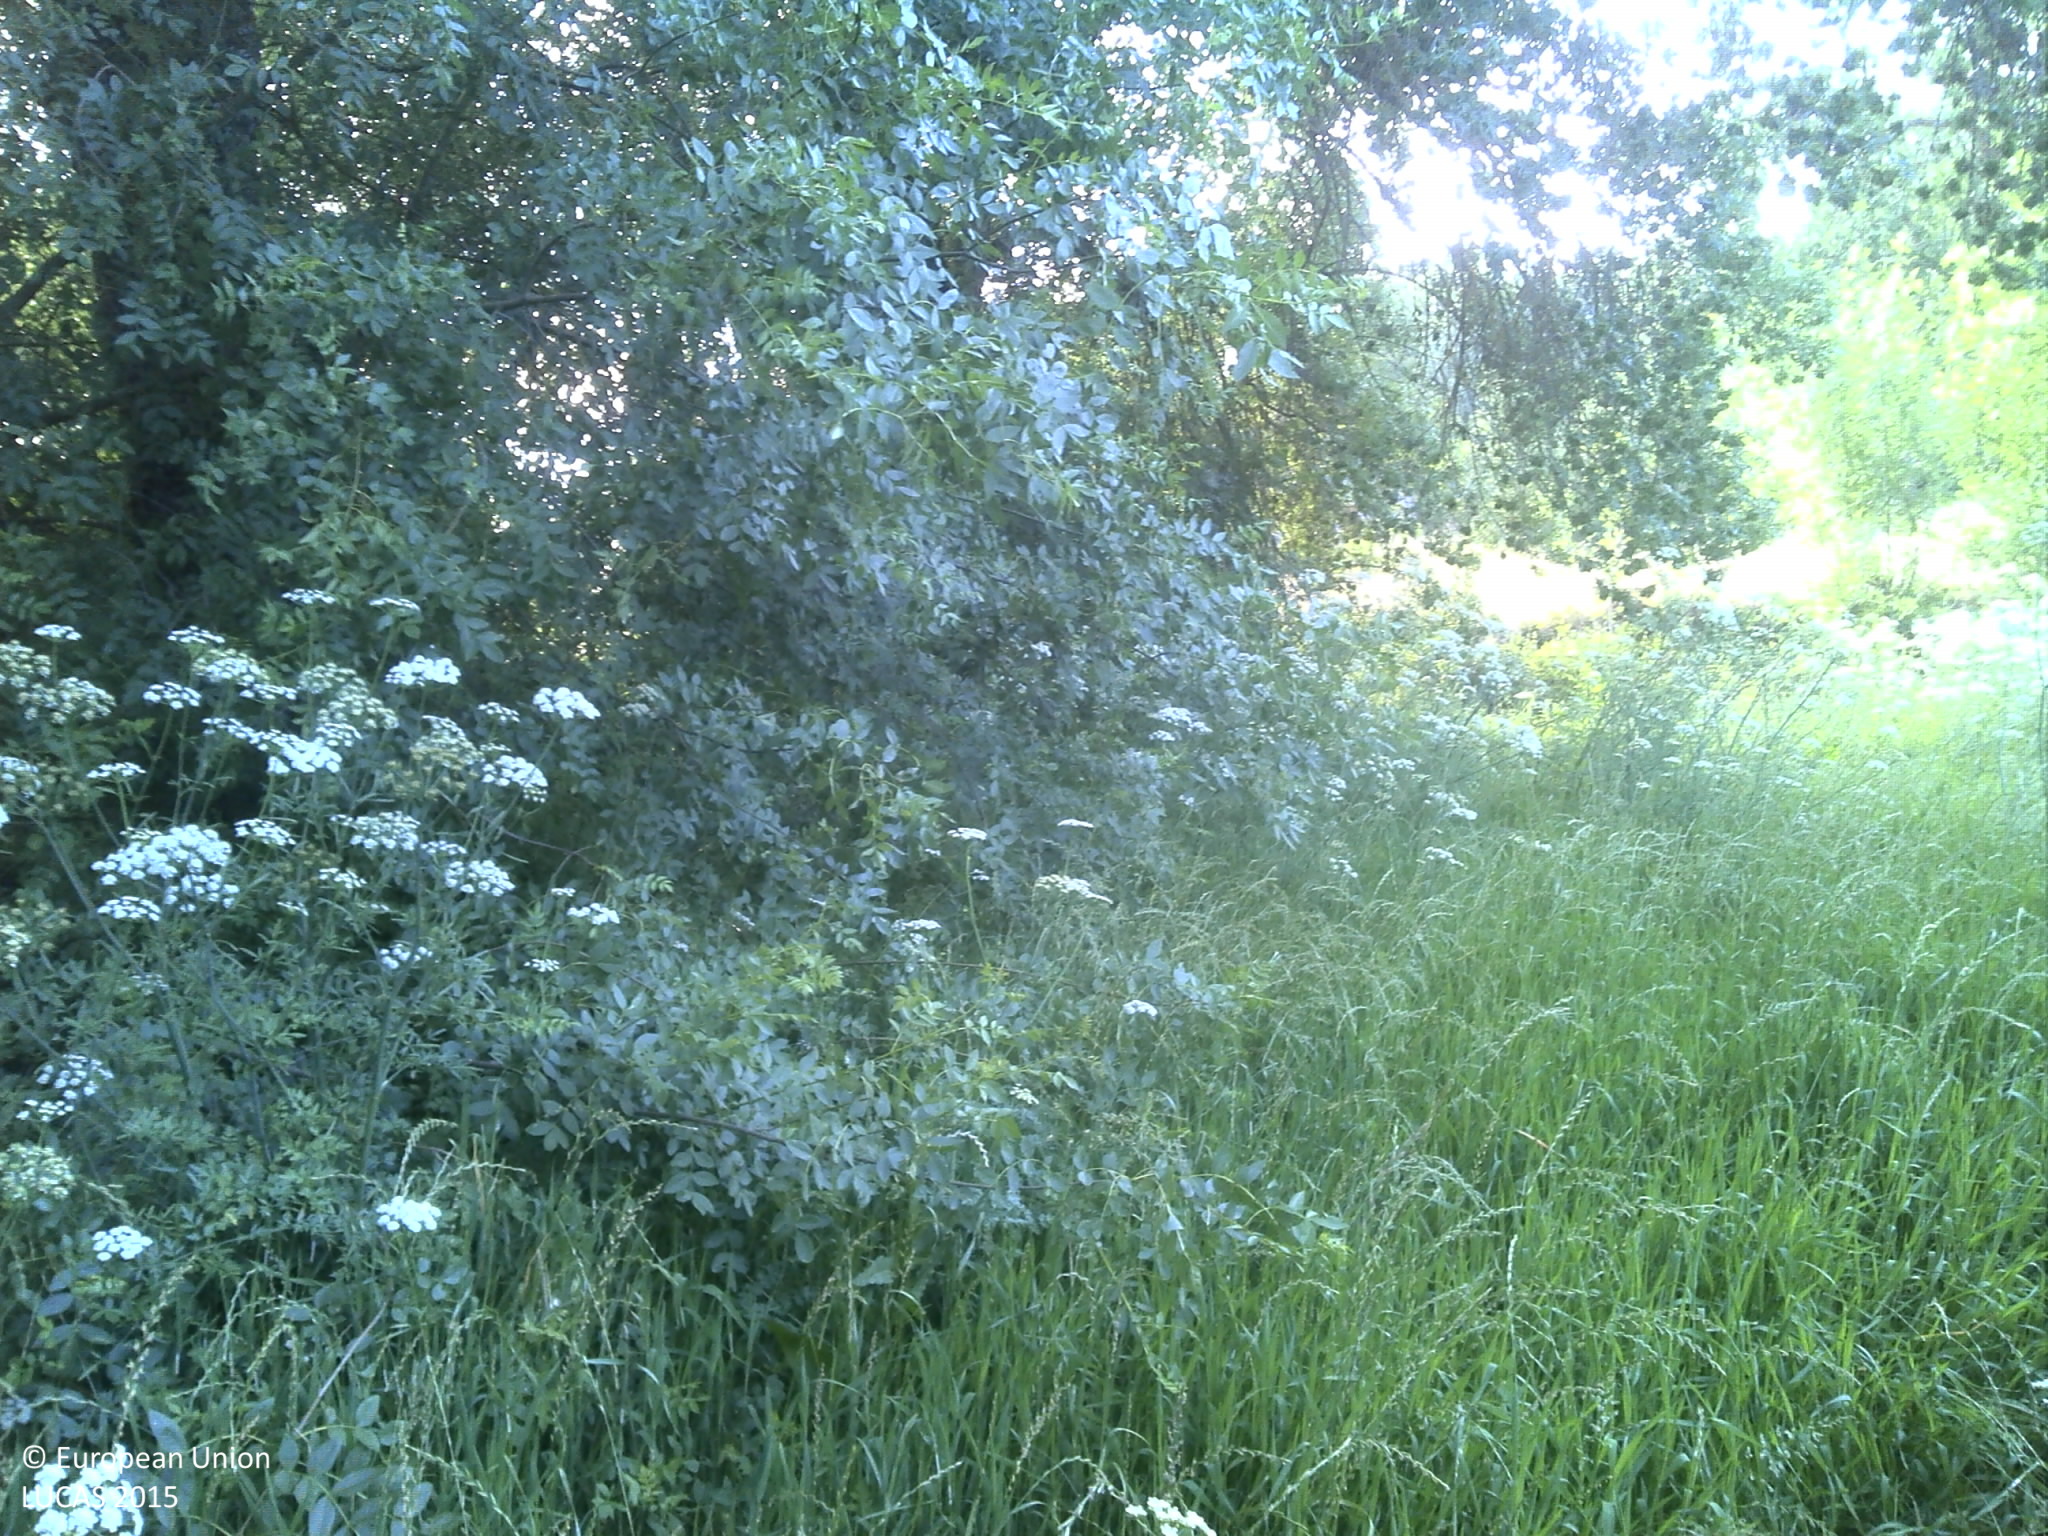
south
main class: Grassland
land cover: Spontaneously vegetated surfaces
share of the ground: 50 - 75 %
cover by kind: herbaceous plants 80 %, unconsolidated bare surface 20 %
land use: Fallow land
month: June
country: PT
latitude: 40.4650
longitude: -7.1193
